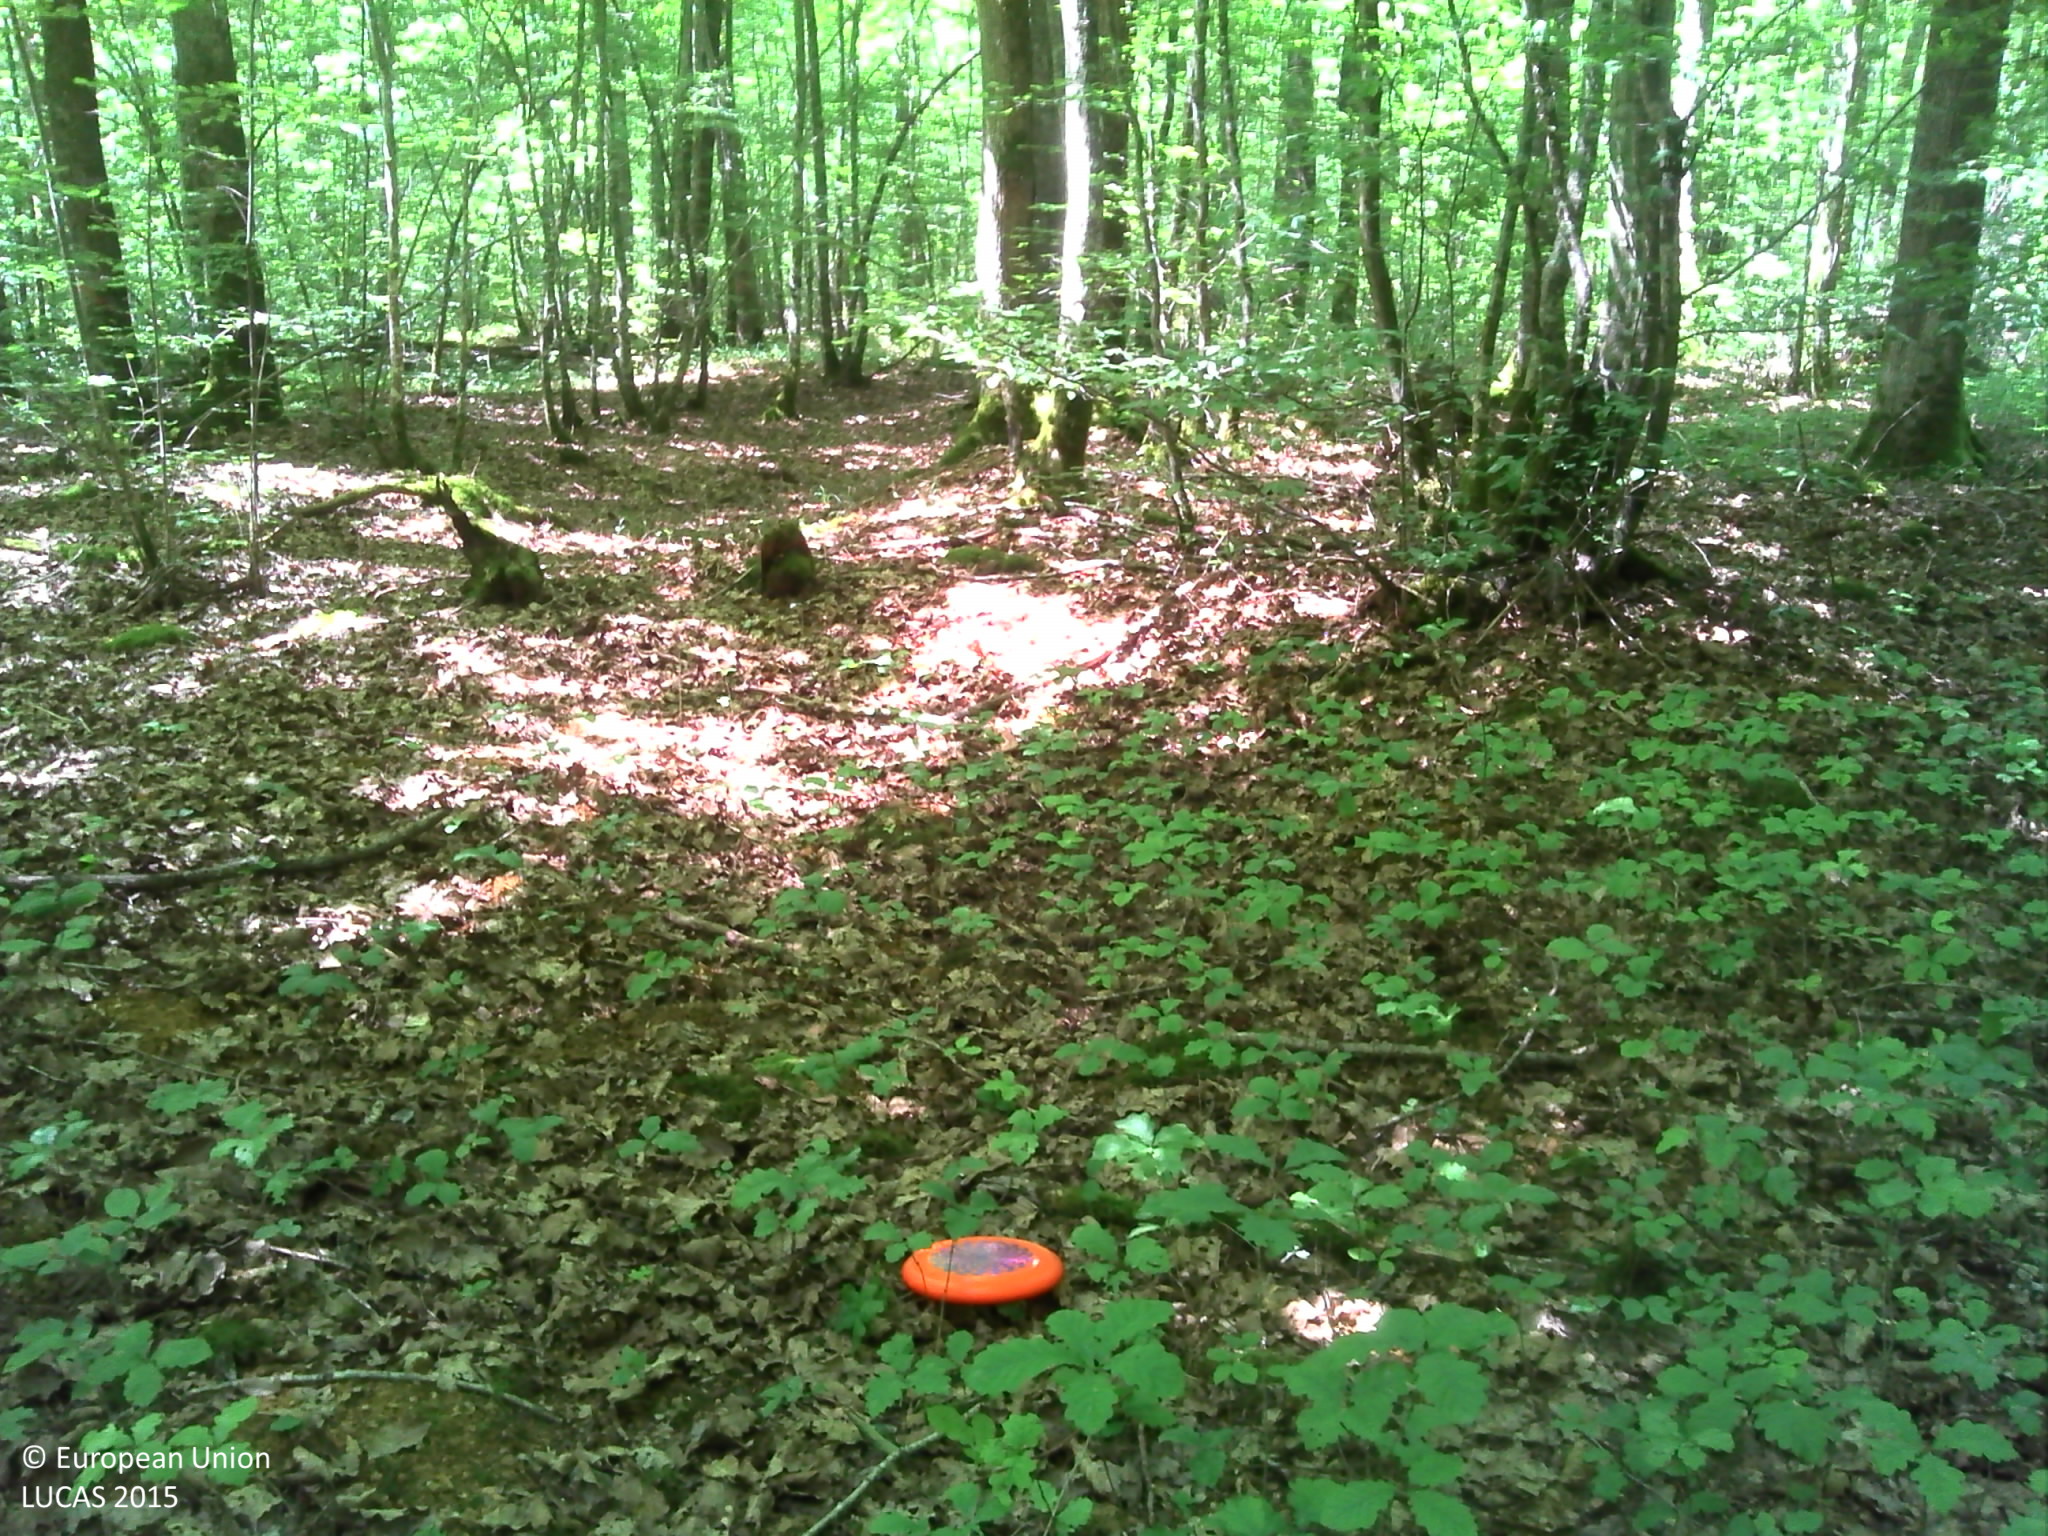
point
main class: Woodland
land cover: Broadleaved woodland
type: mesophytic deciduous forest
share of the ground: > 75 %
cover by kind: broadleaved forest trees 90 %, herbaceous plants 5 %, lichens and mosses 5 %
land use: Forestry
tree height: > 5 m
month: June
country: FR
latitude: 47.4772
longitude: 3.5874
